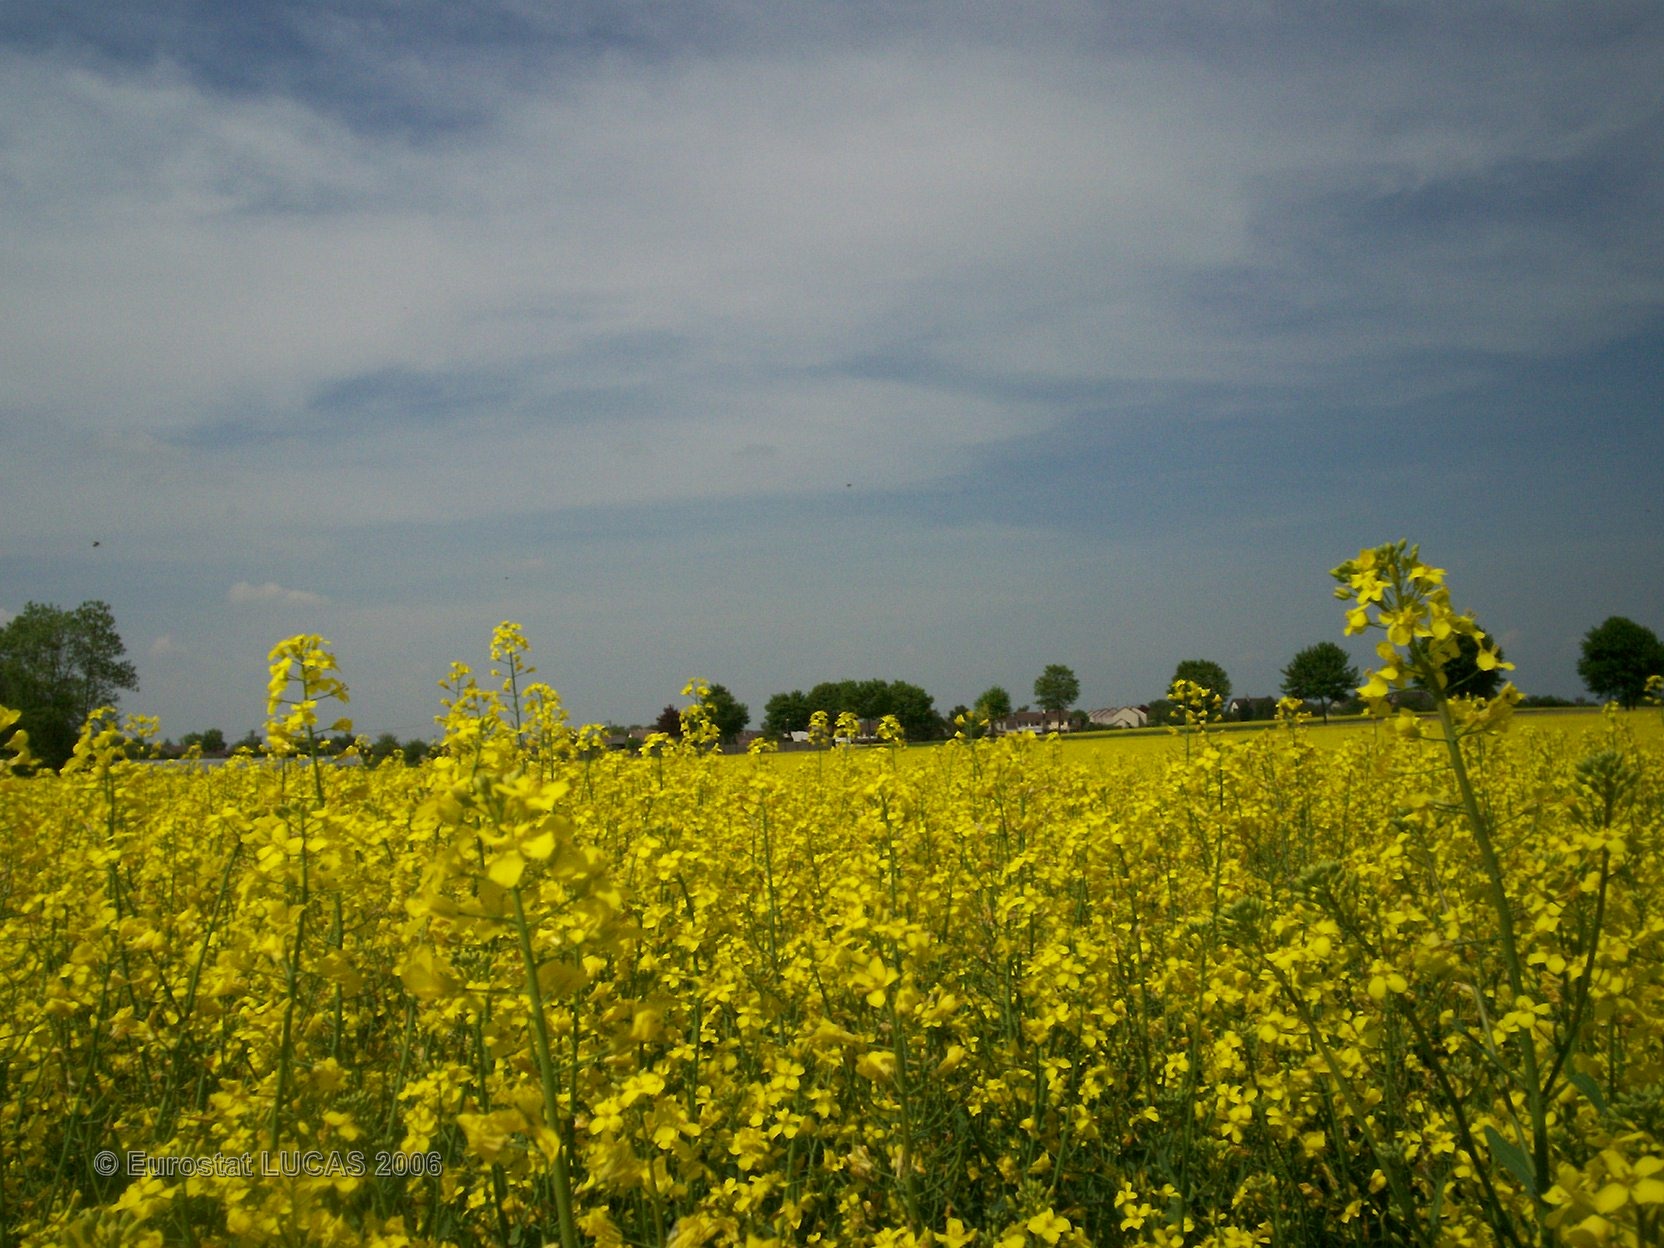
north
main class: Cropland
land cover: Rape and turnip rape
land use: Agriculture (excluding fallow land and kitchen gardens)
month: May
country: FR
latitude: 48.9116
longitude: 4.4158
